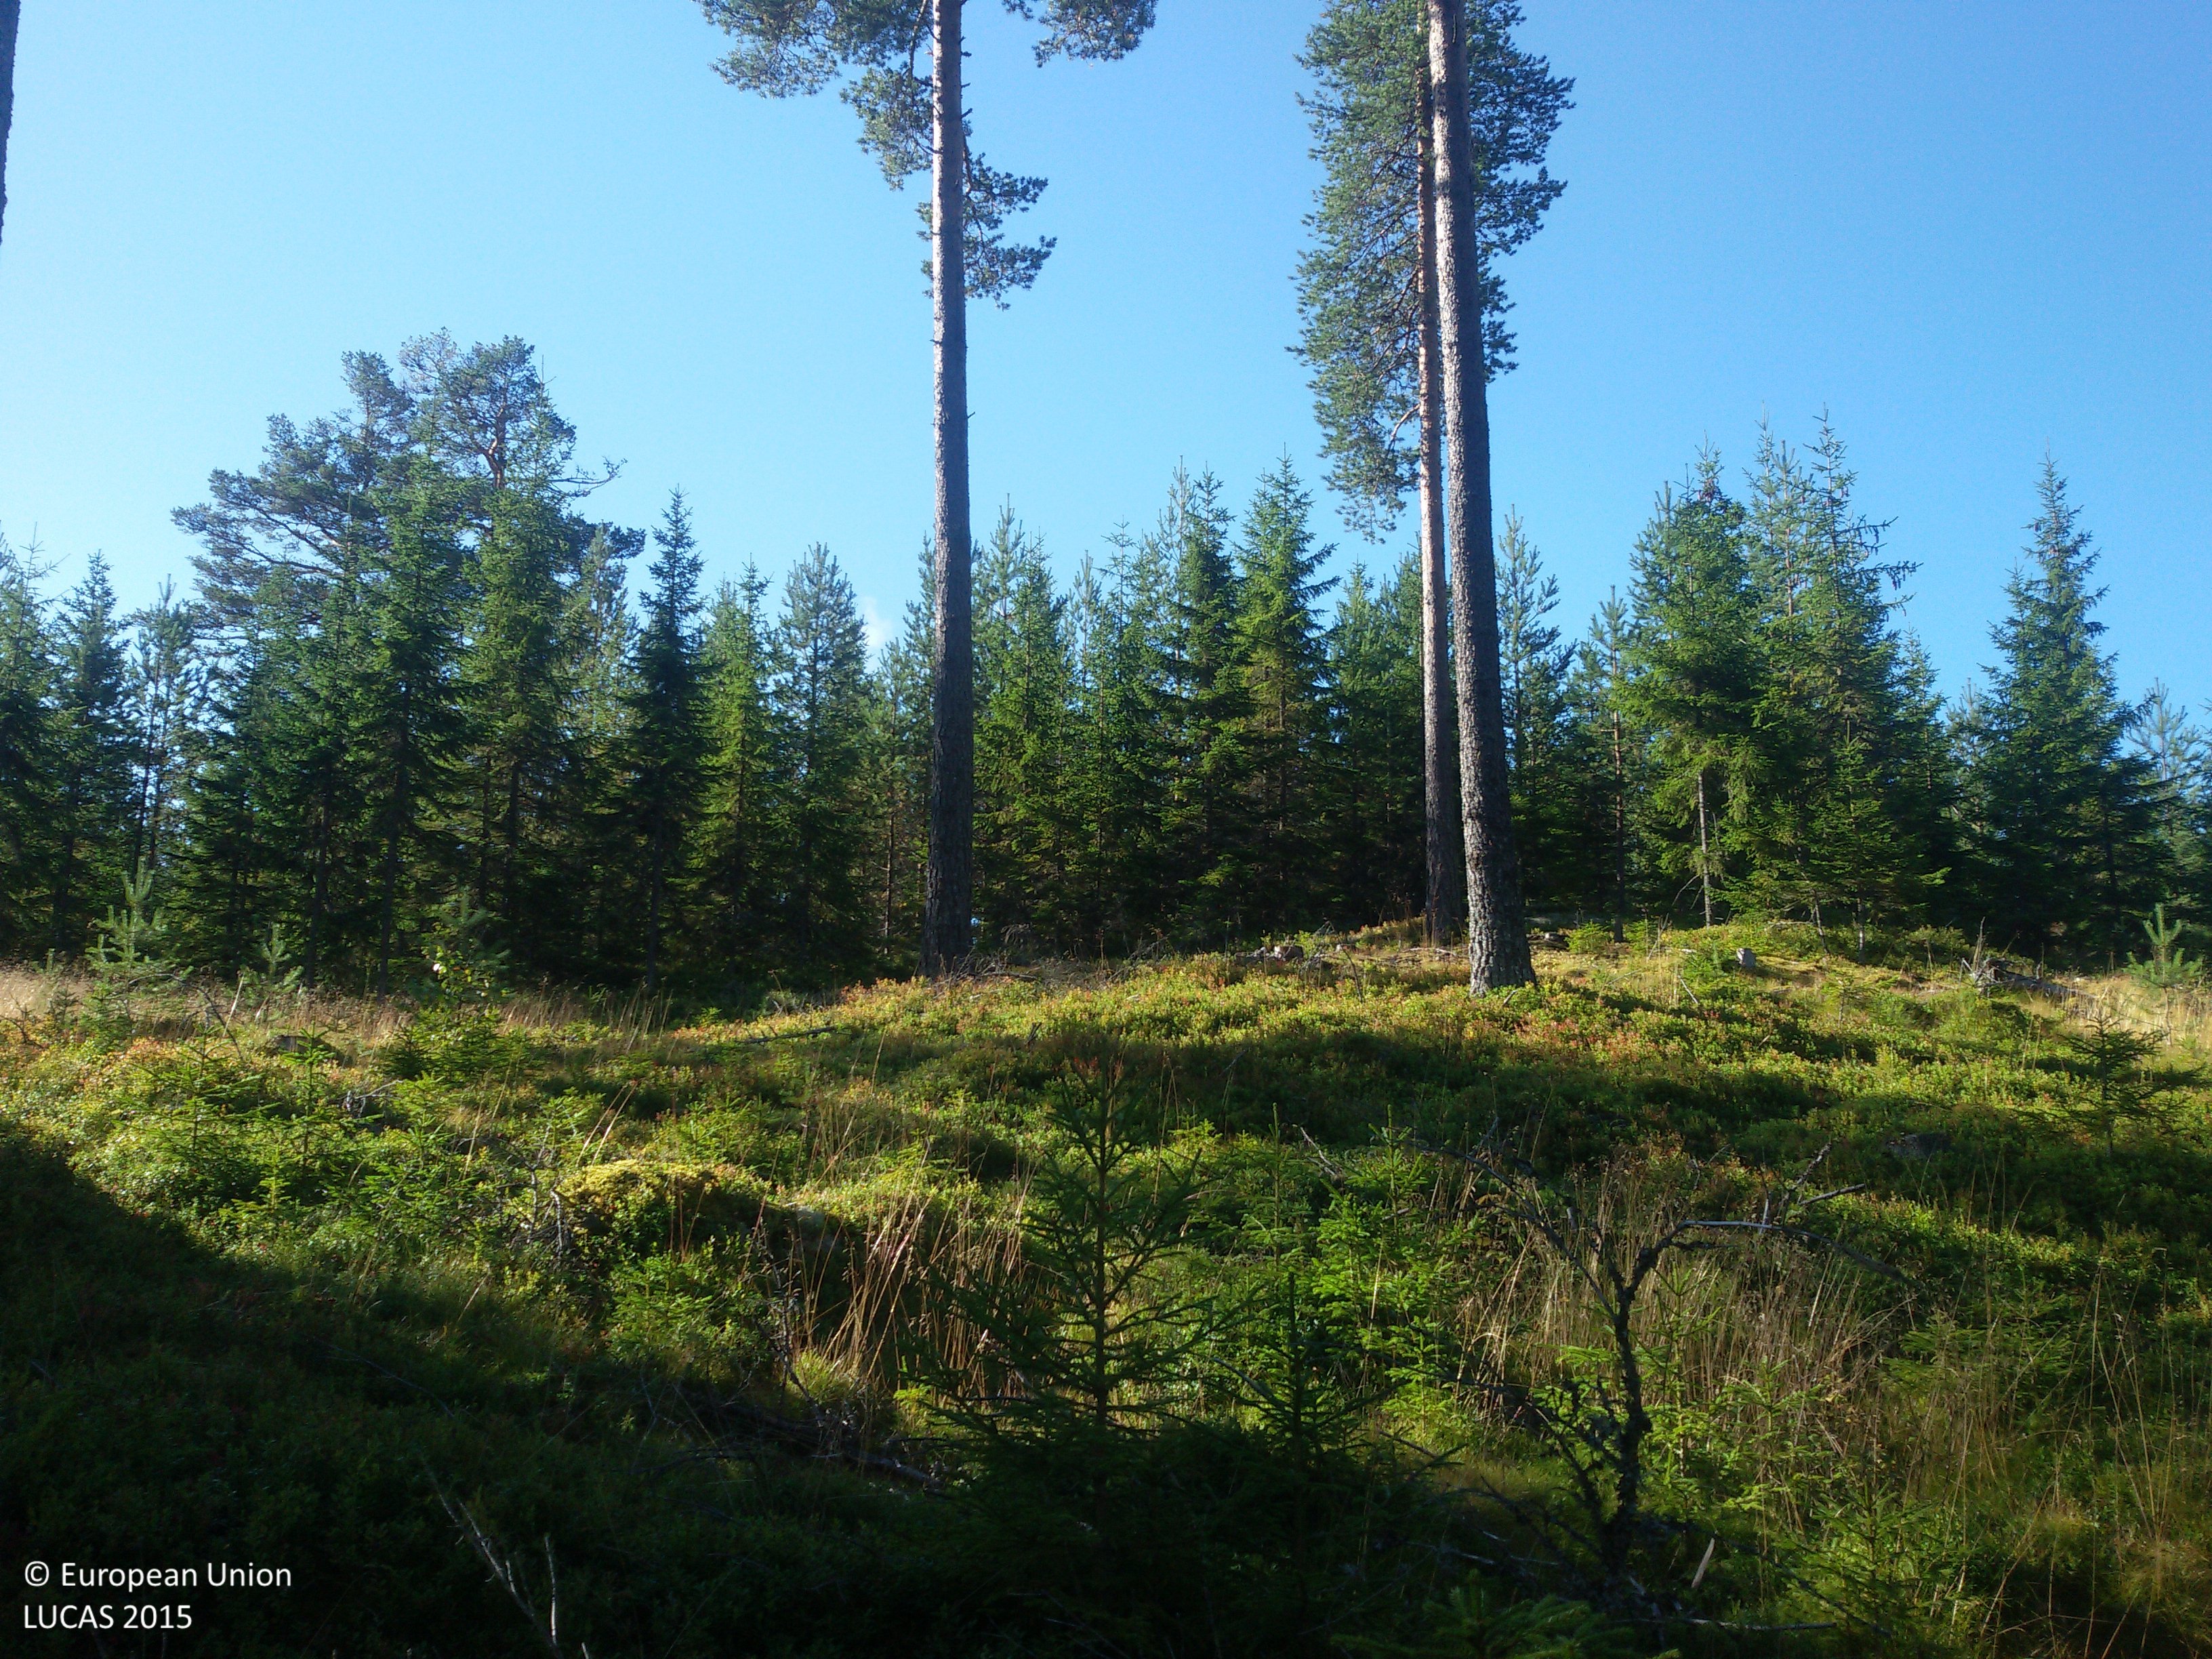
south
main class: Woodland
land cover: Pine dominated coniferous woodland
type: boreal forest
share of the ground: 25 - 50 %
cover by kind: shrubs 50 %, coniferous forest trees 40 %, lichens and mosses 10 %
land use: Forestry
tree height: > 5 m
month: September
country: SE
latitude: 60.8736
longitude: 15.3460
